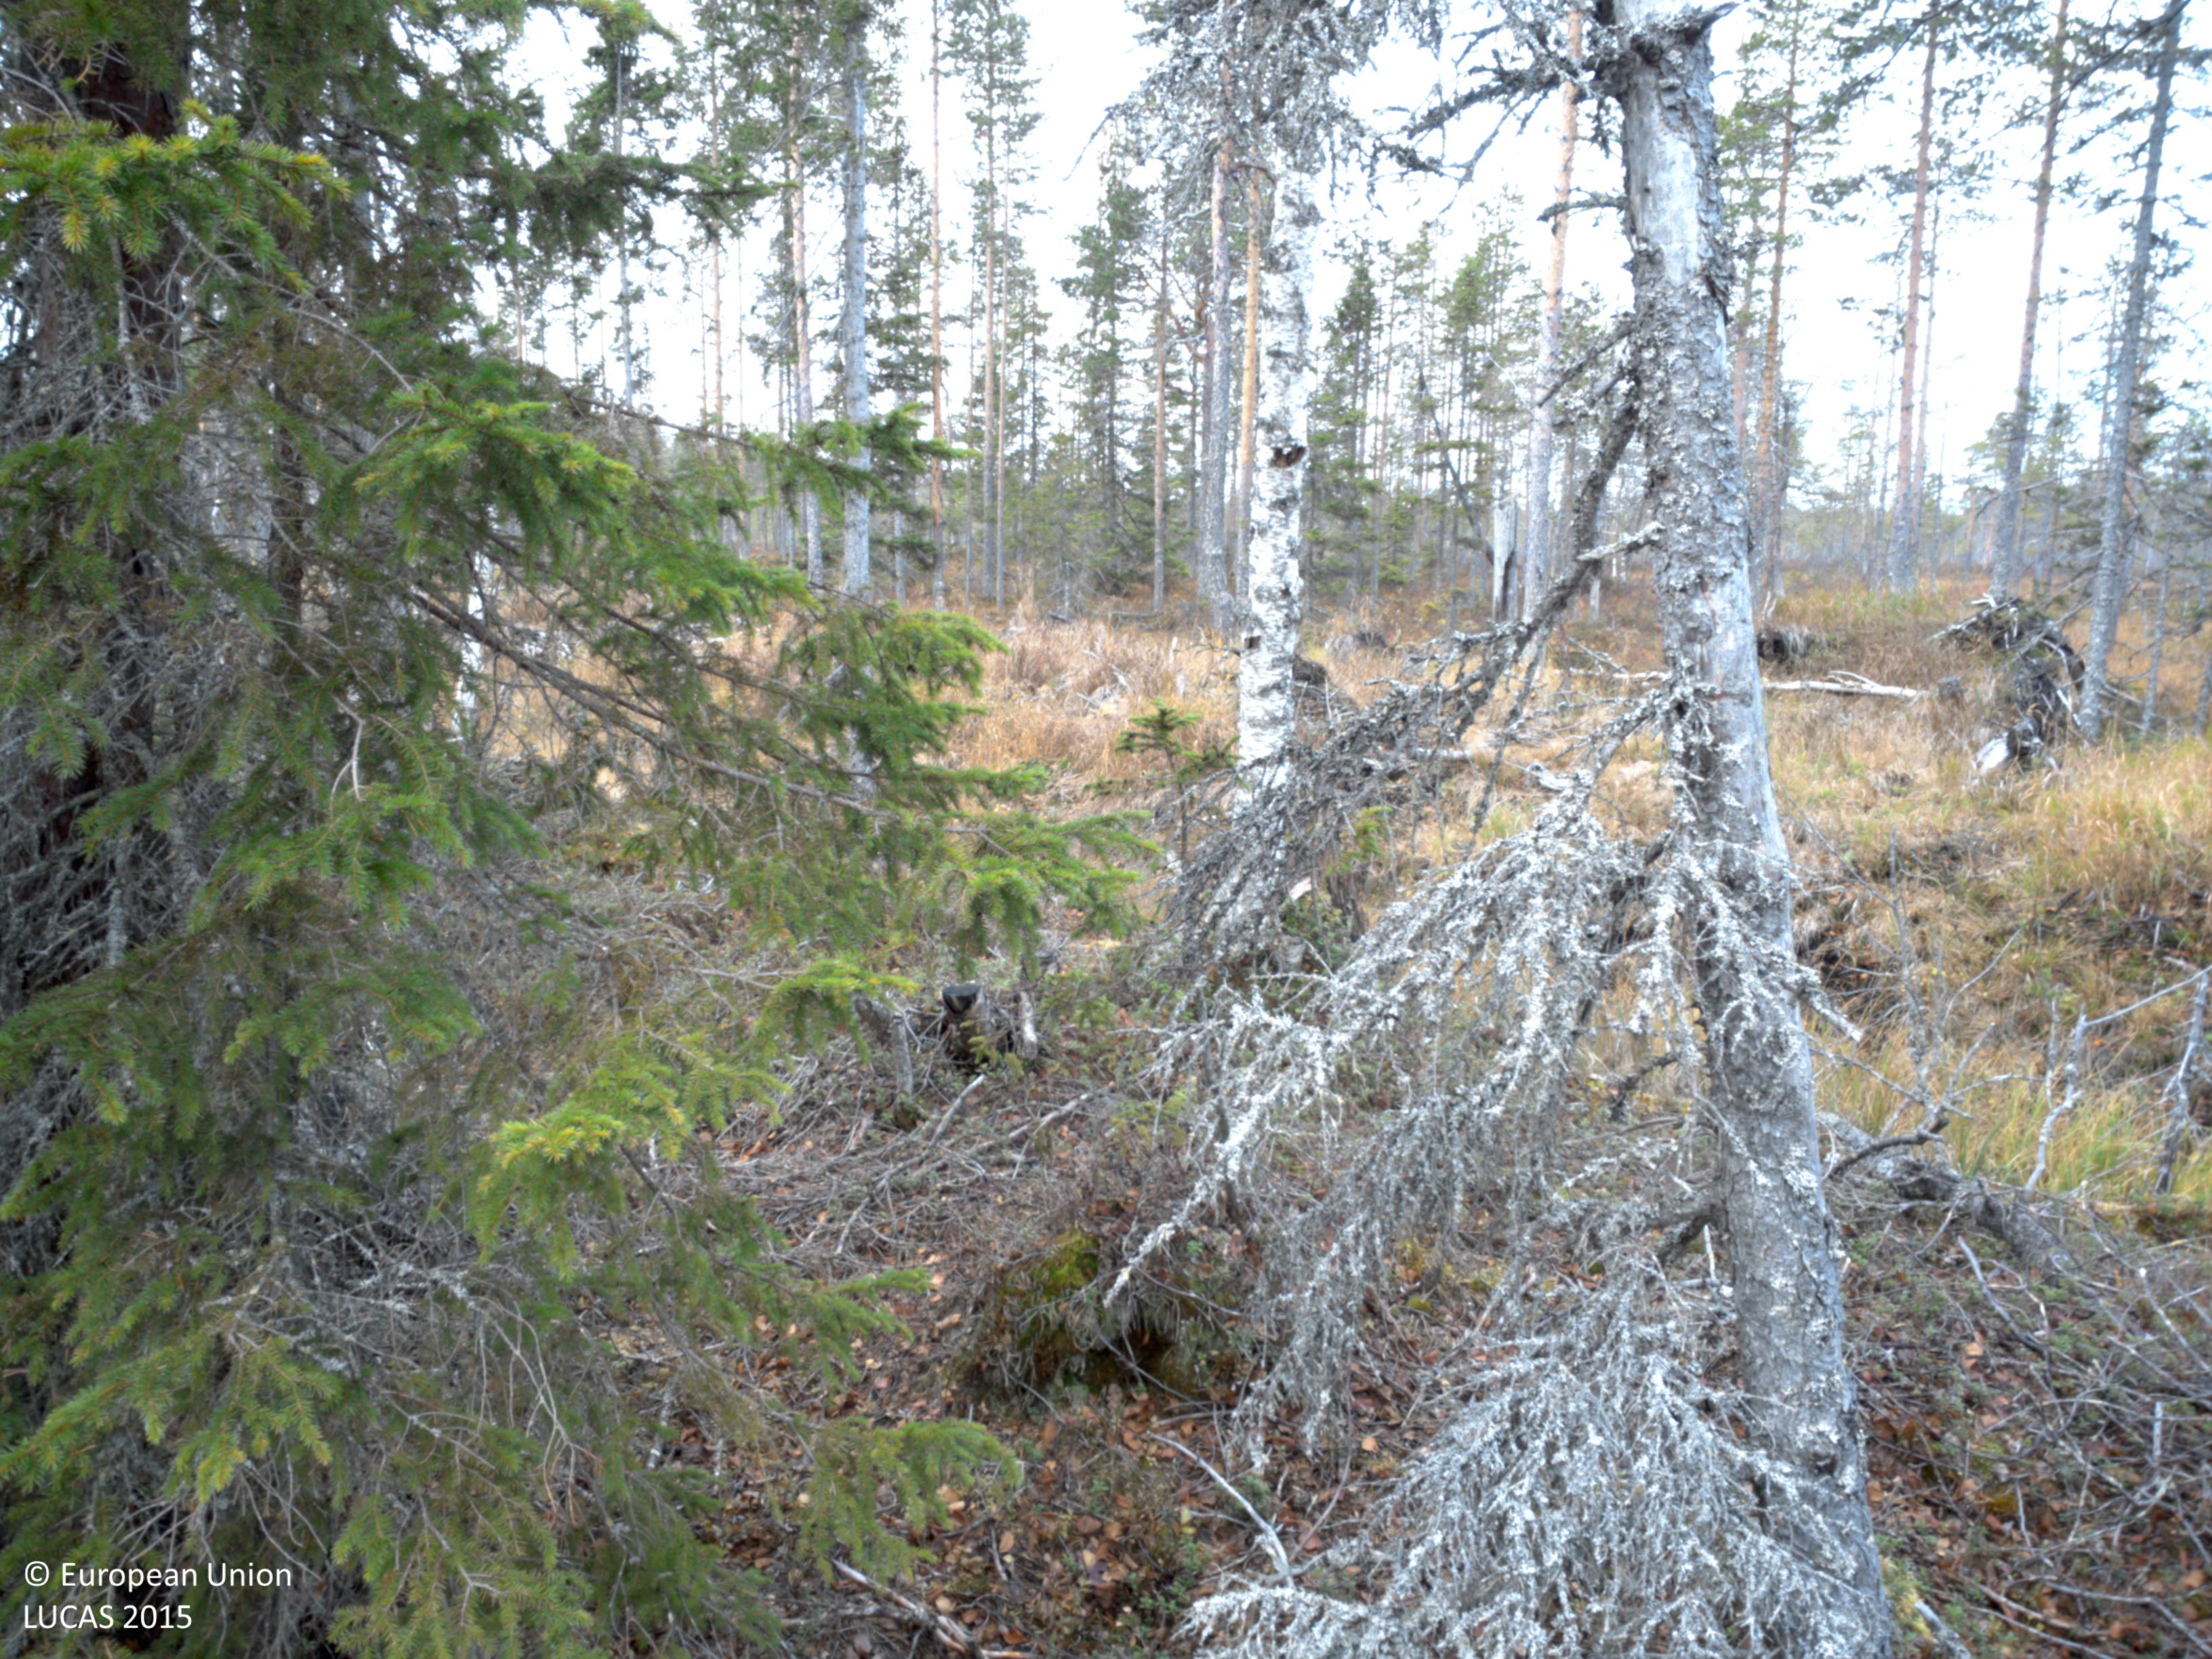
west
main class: Woodland
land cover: Pine dominated mixed woodland
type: mire and swamp forests
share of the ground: 25 - 50 %
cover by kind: coniferous forest trees 25 %, shrubs 25 %, lichens and mosses 25 %, herbaceous plants 15 %, broadleaved forest trees 10 %
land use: Forestry
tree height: > 5 m
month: October
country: SE
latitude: 64.6271
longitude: 18.1029
